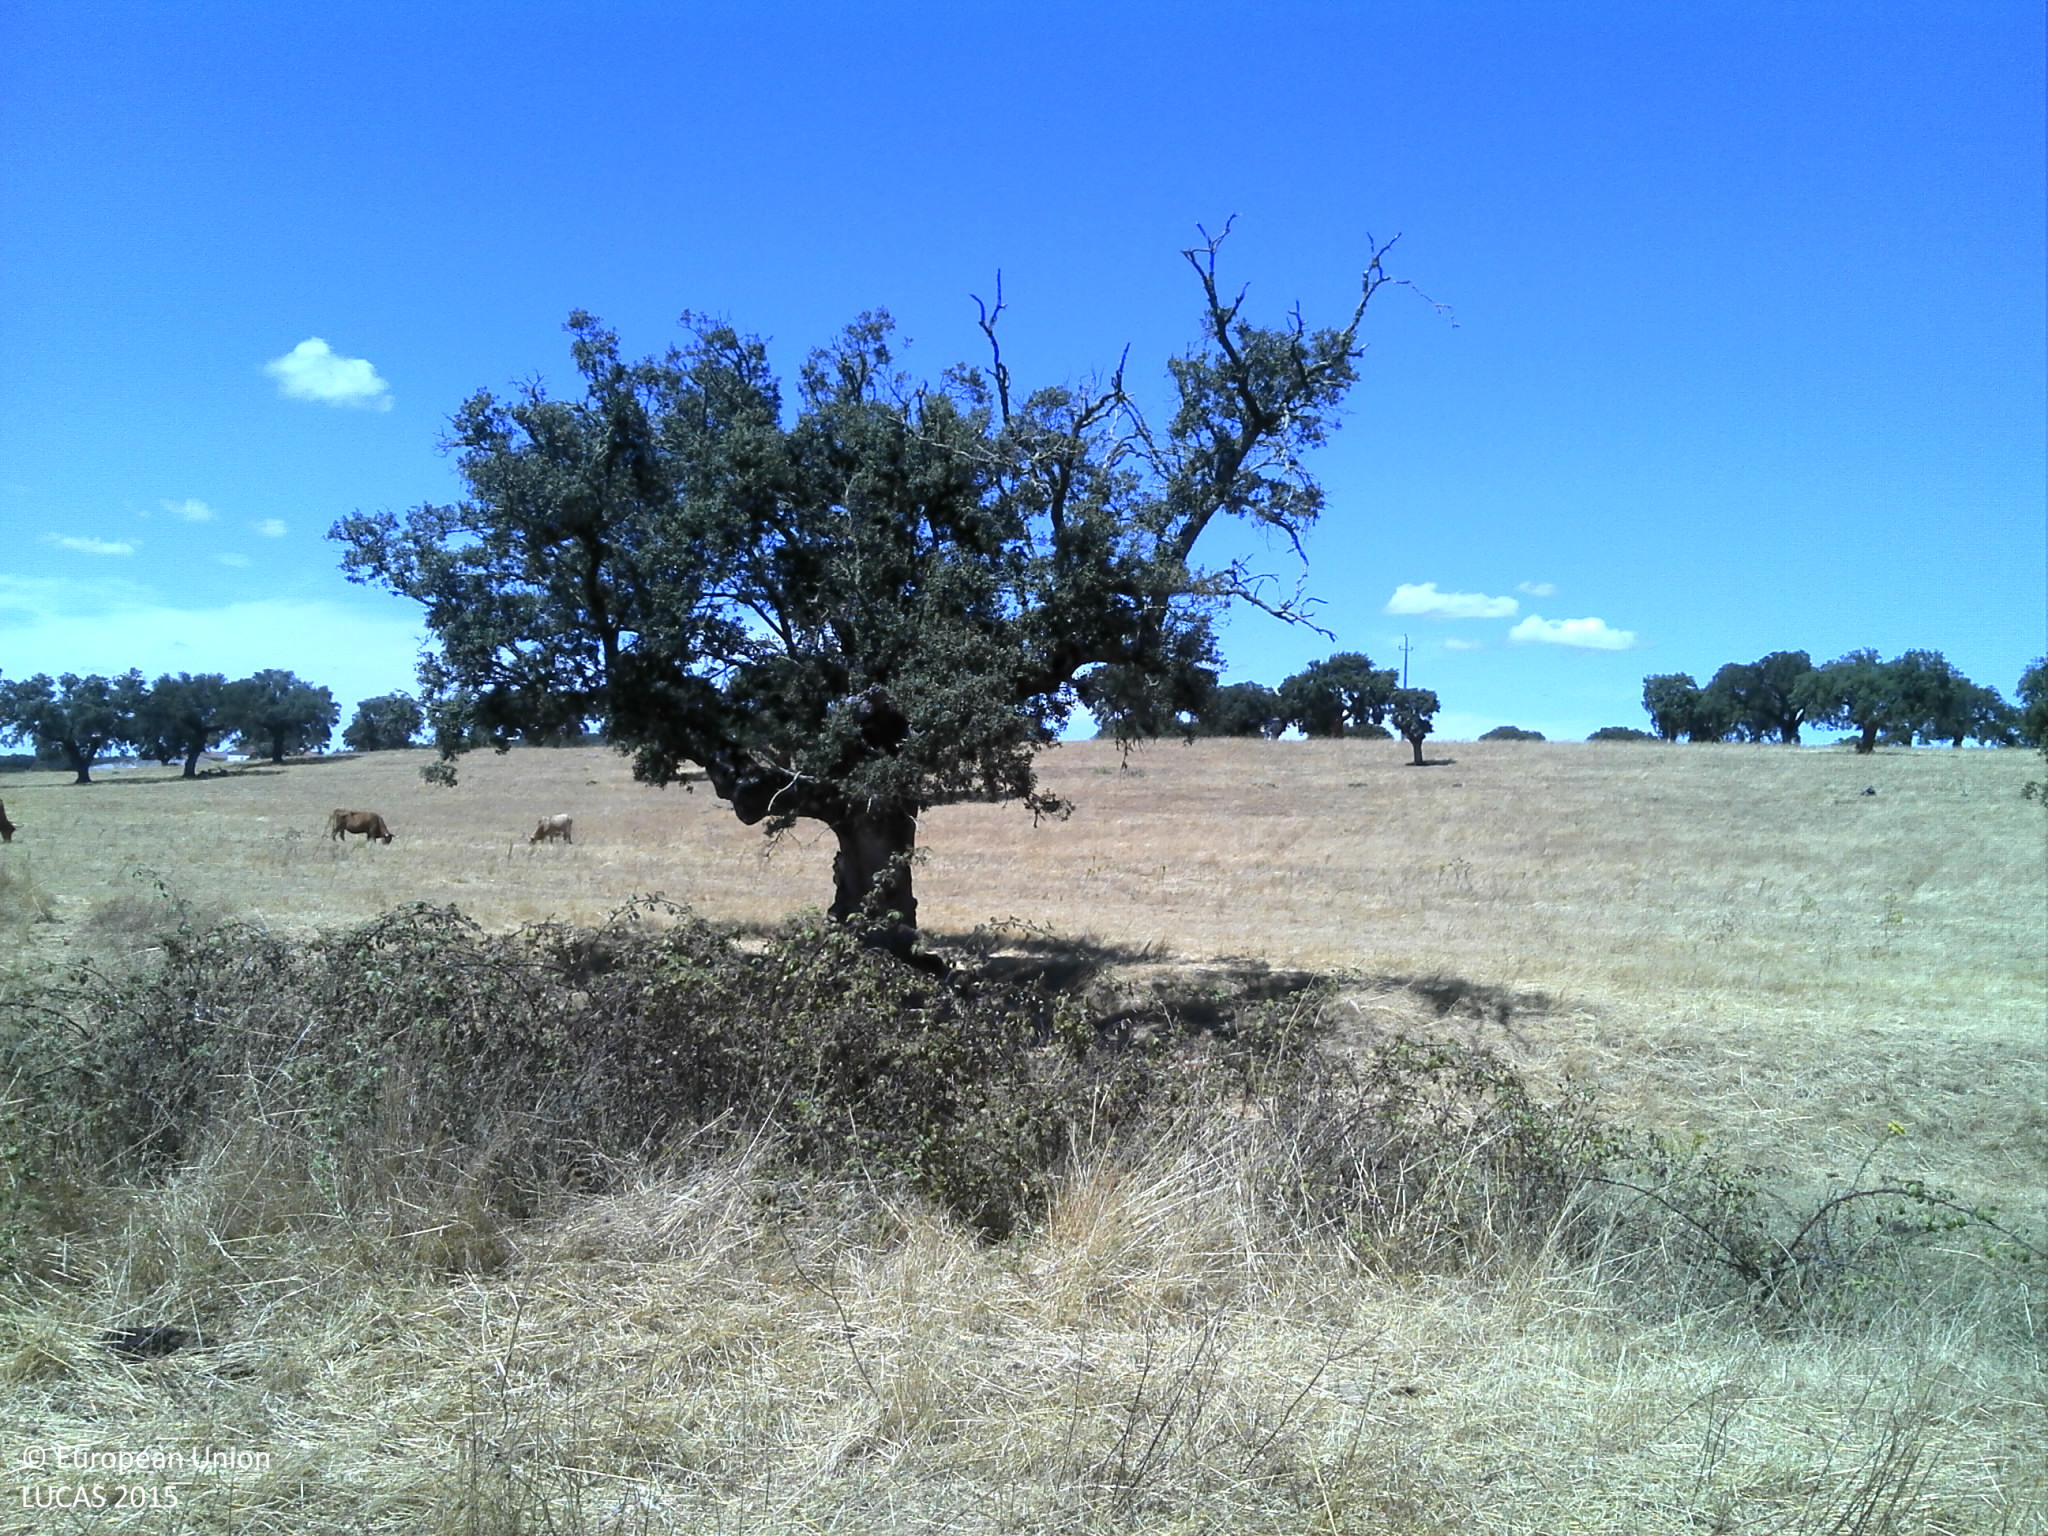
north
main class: Grassland
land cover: Grassland without tree/shrub cover
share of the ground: 50 - 75 %
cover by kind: herbaceous plants 60 %, unconsolidated bare surface 40 %
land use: Agriculture (excluding fallow land and kitchen gardens)
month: July
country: PT
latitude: 39.1899
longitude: -7.4411
